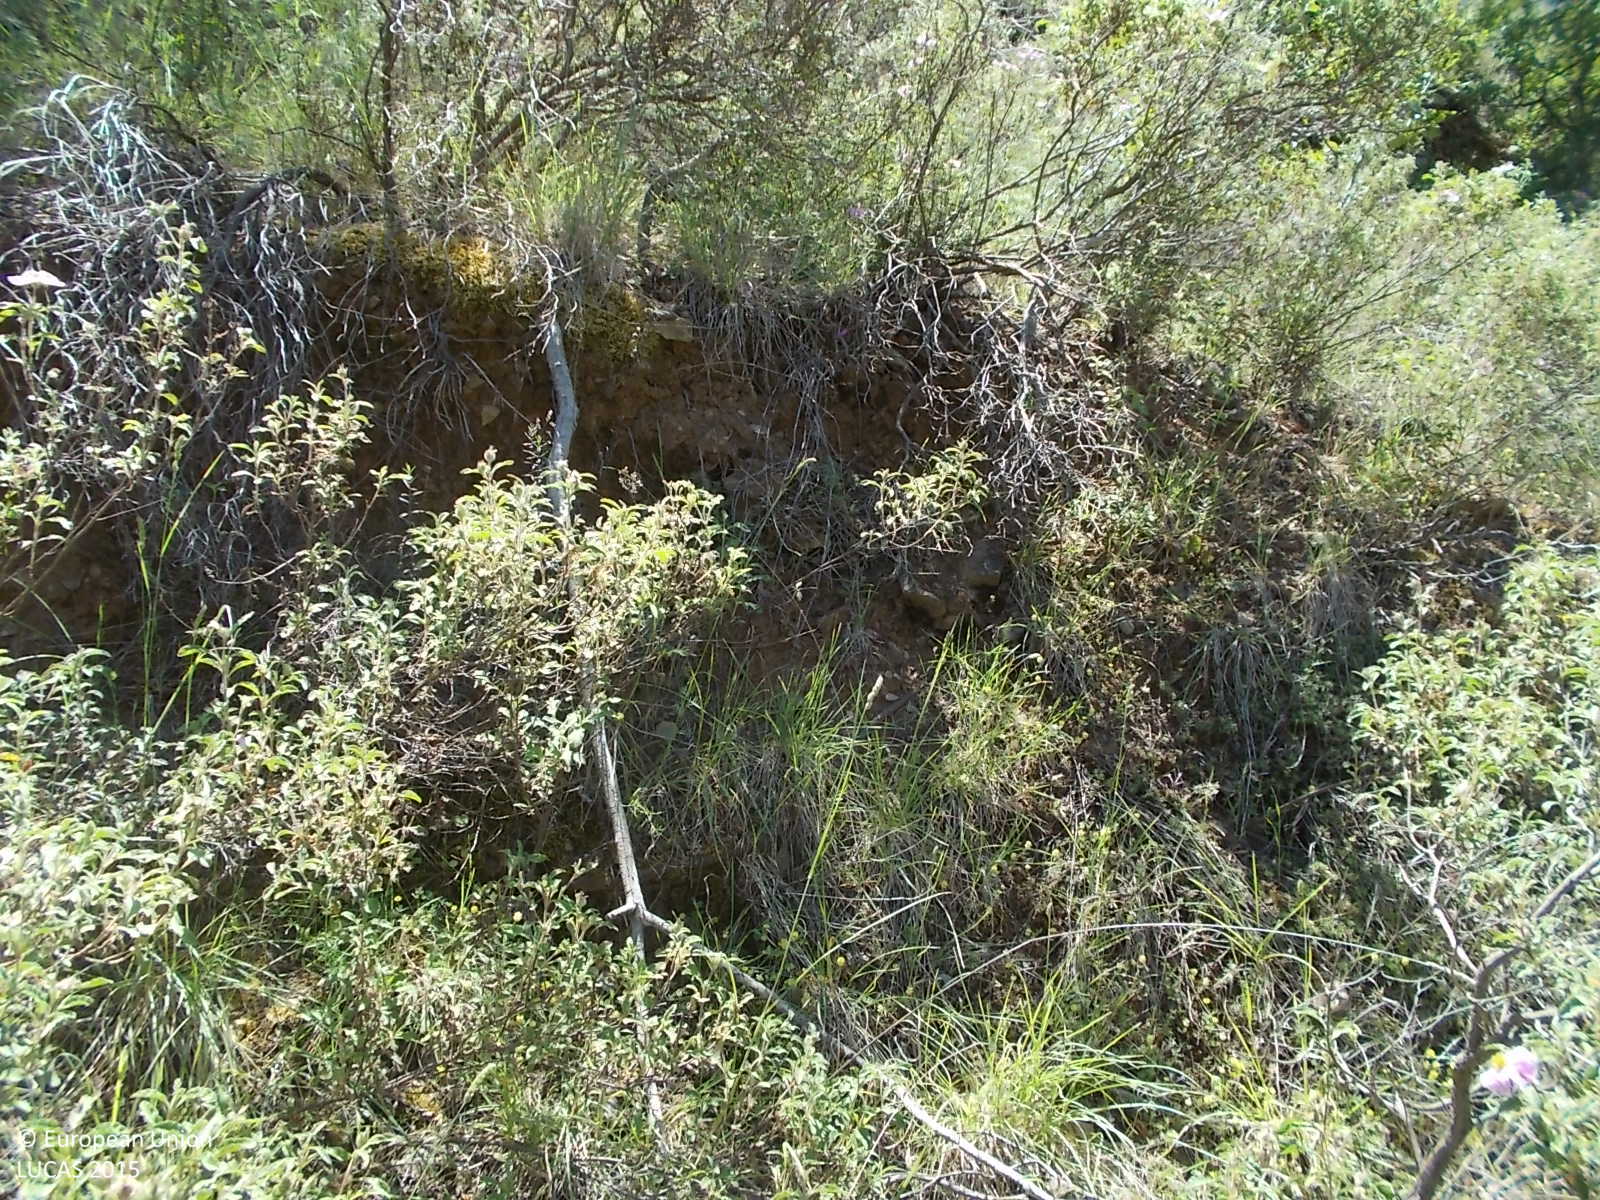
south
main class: Shrubland
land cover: Shrubland with sparse tree cover
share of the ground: > 75 %
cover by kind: shrubs 90 %, broadleaved forest trees 5 %, unconsolidated bare surface 5 %
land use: Semi-natural and natural areas not in use
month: May
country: CY
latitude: 34.9633
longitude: 33.1444
